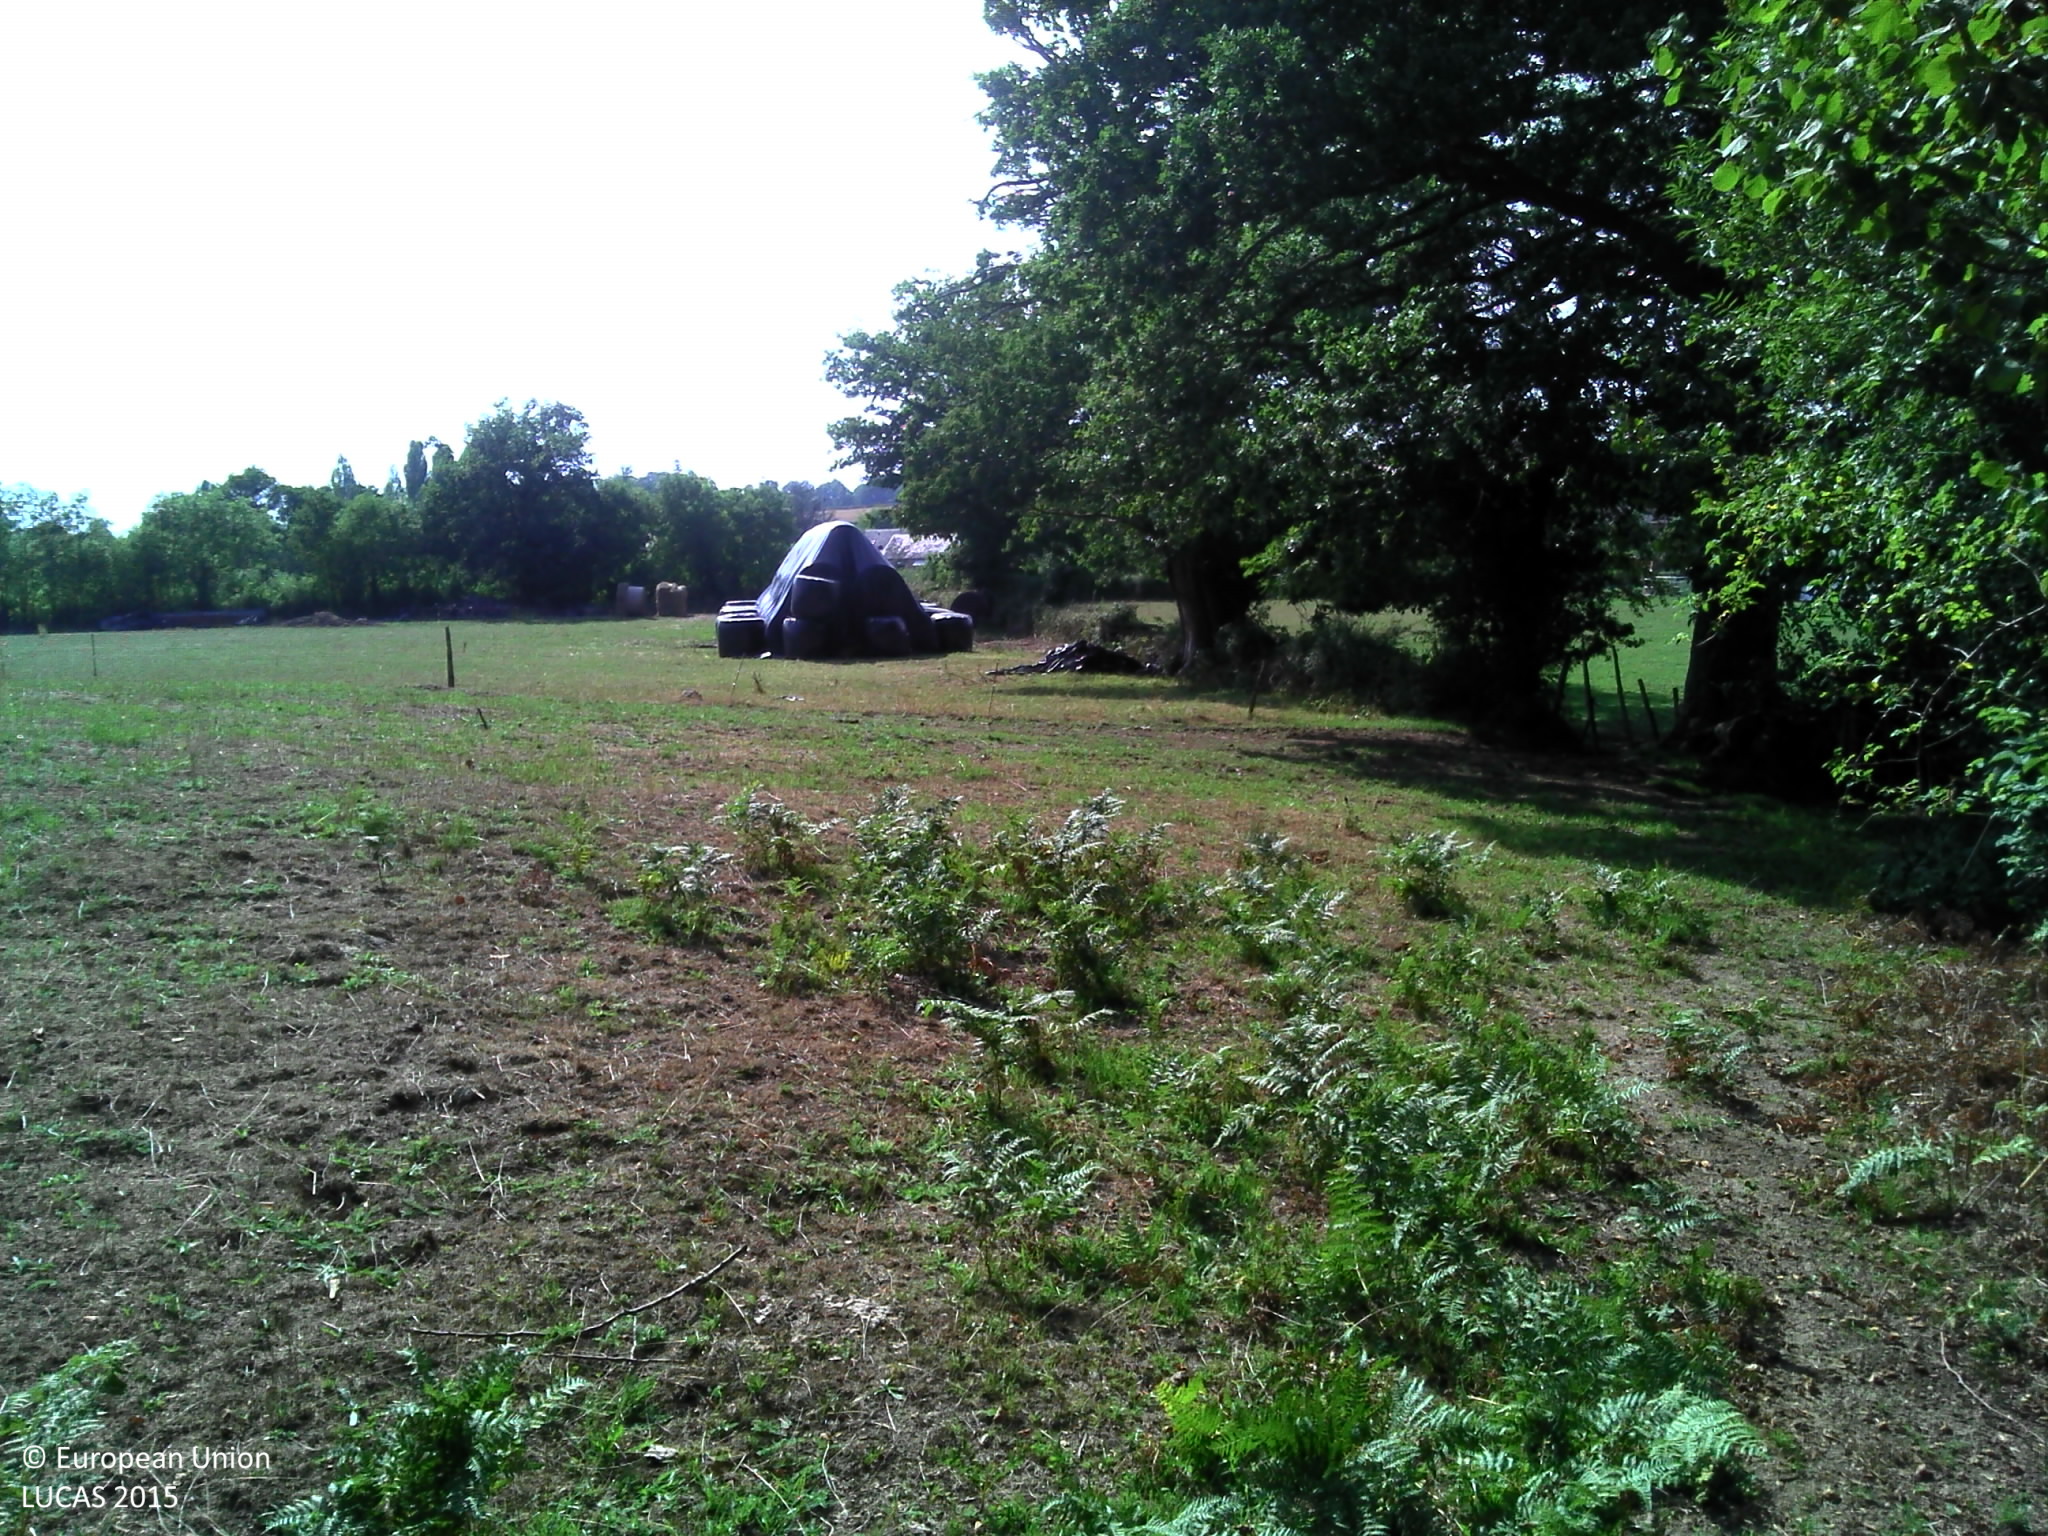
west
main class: Grassland
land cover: Grassland with sparse tree/shrub cover
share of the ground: > 75 %
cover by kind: herbaceous plants 90 %, broadleaved forest trees 5 %, shrubs 5 %
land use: Agriculture (excluding fallow land and kitchen gardens)
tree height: > 5 m
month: August
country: FR
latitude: 46.2686
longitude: 2.2484
